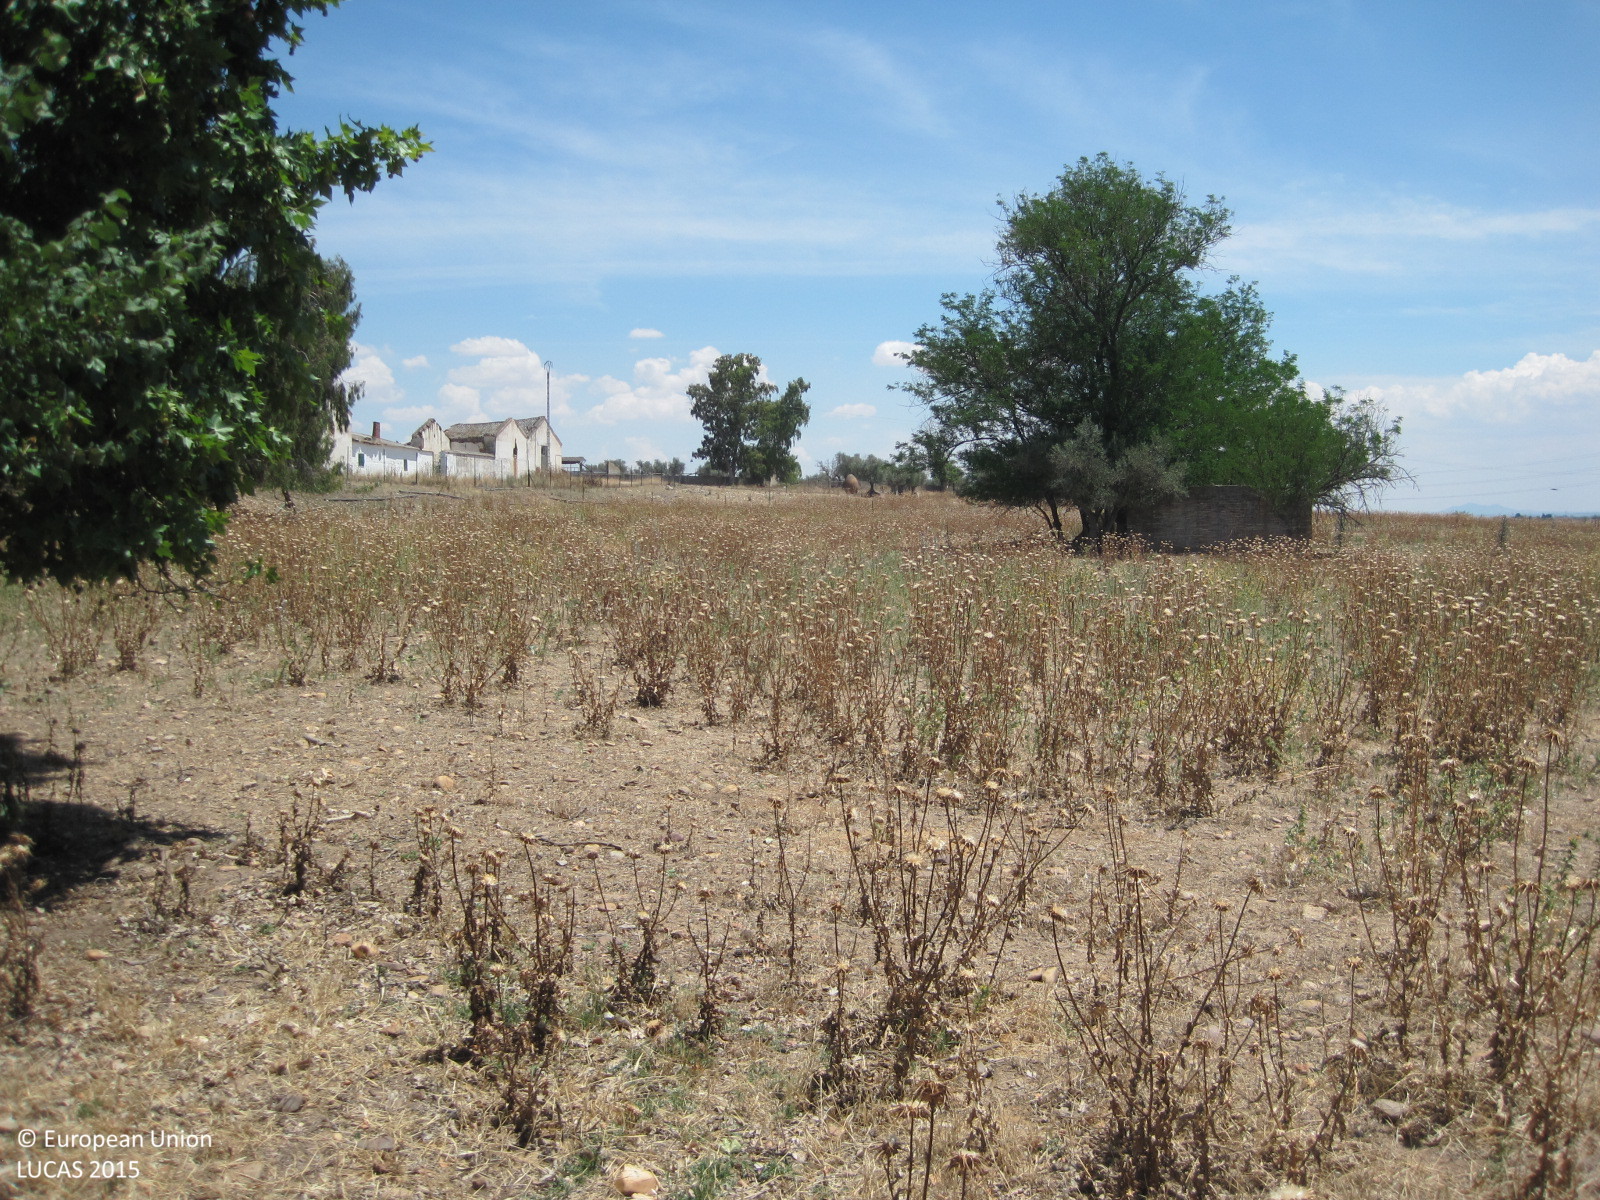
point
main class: Grassland
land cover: Grassland with sparse tree/shrub cover
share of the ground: > 75 %
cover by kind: herbaceous plants 70 %, unconsolidated bare surface 25 %, coniferous forest trees 5 %
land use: Agriculture (excluding fallow land and kitchen gardens)
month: June
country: ES
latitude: 39.9800
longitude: -4.6949
